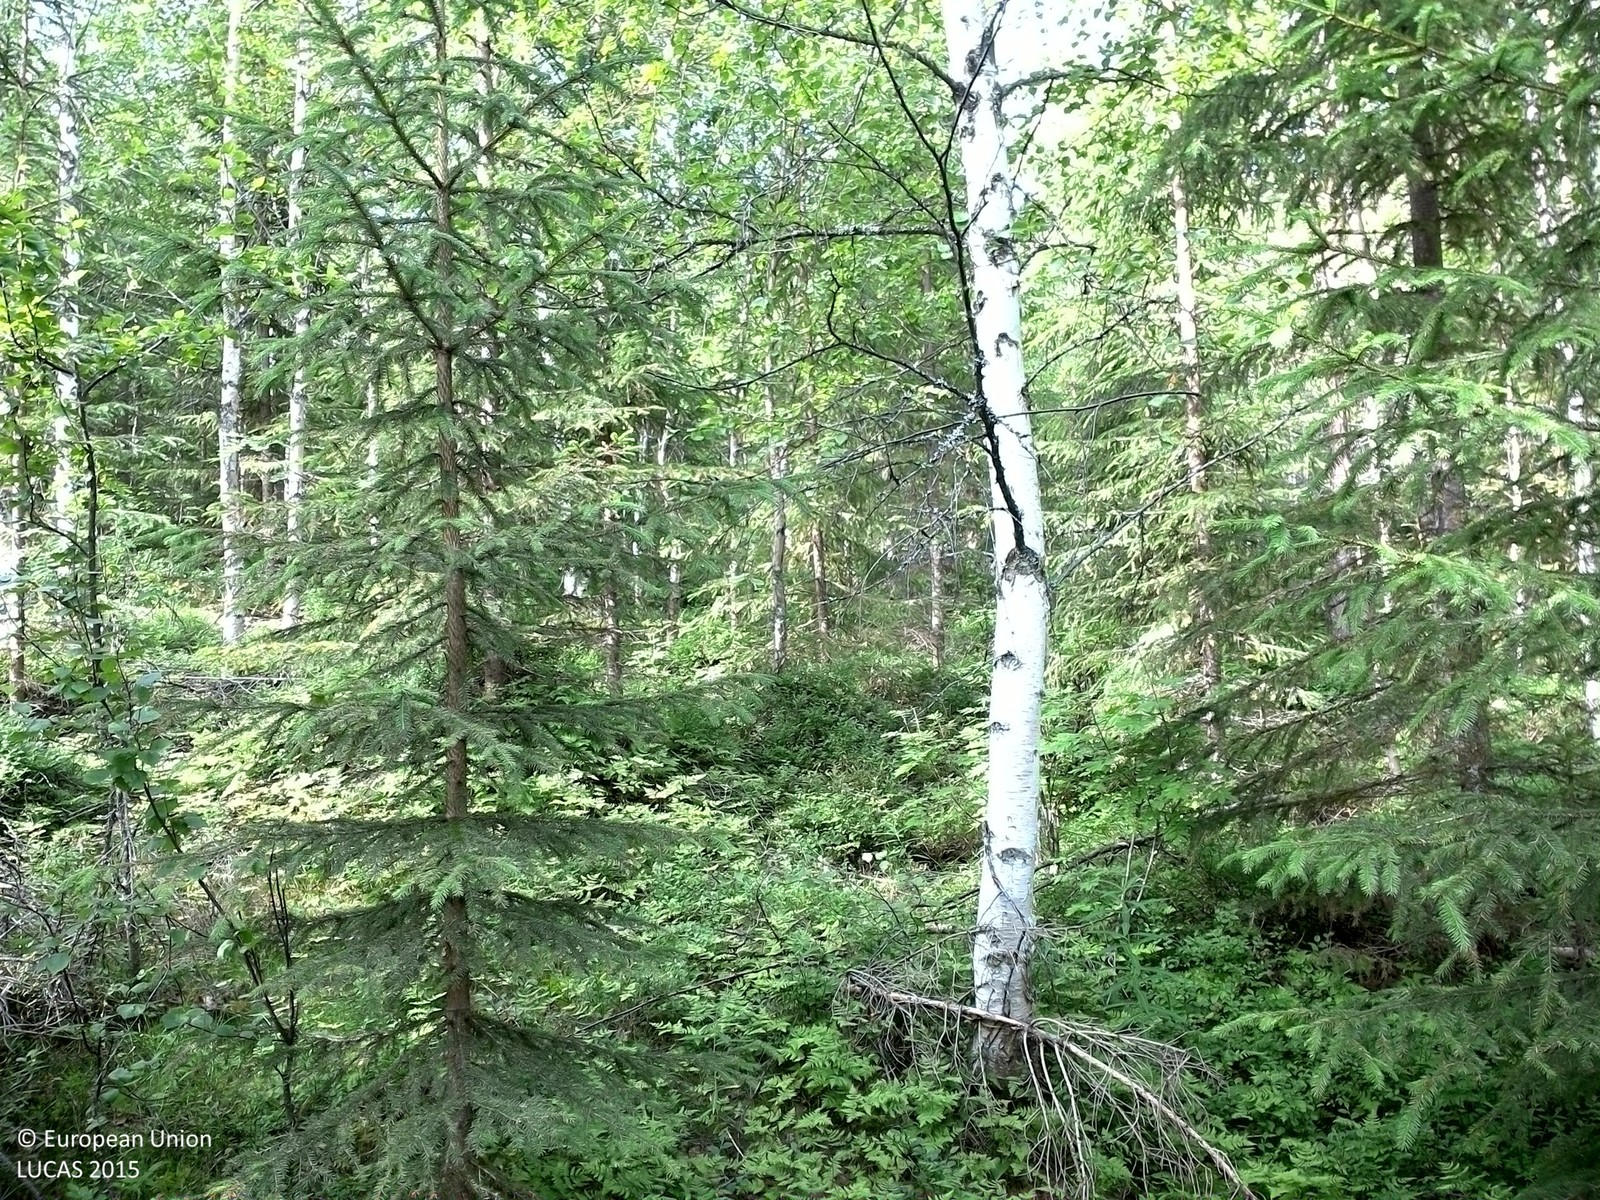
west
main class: Woodland
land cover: Spruce dominated mixed woodland
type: boreal forest
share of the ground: > 75 %
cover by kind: coniferous forest trees 40 %, broadleaved forest trees 35 %, shrubs 25 %
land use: Forestry
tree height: < 5 m
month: August
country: SE
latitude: 63.7131
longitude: 18.2108
